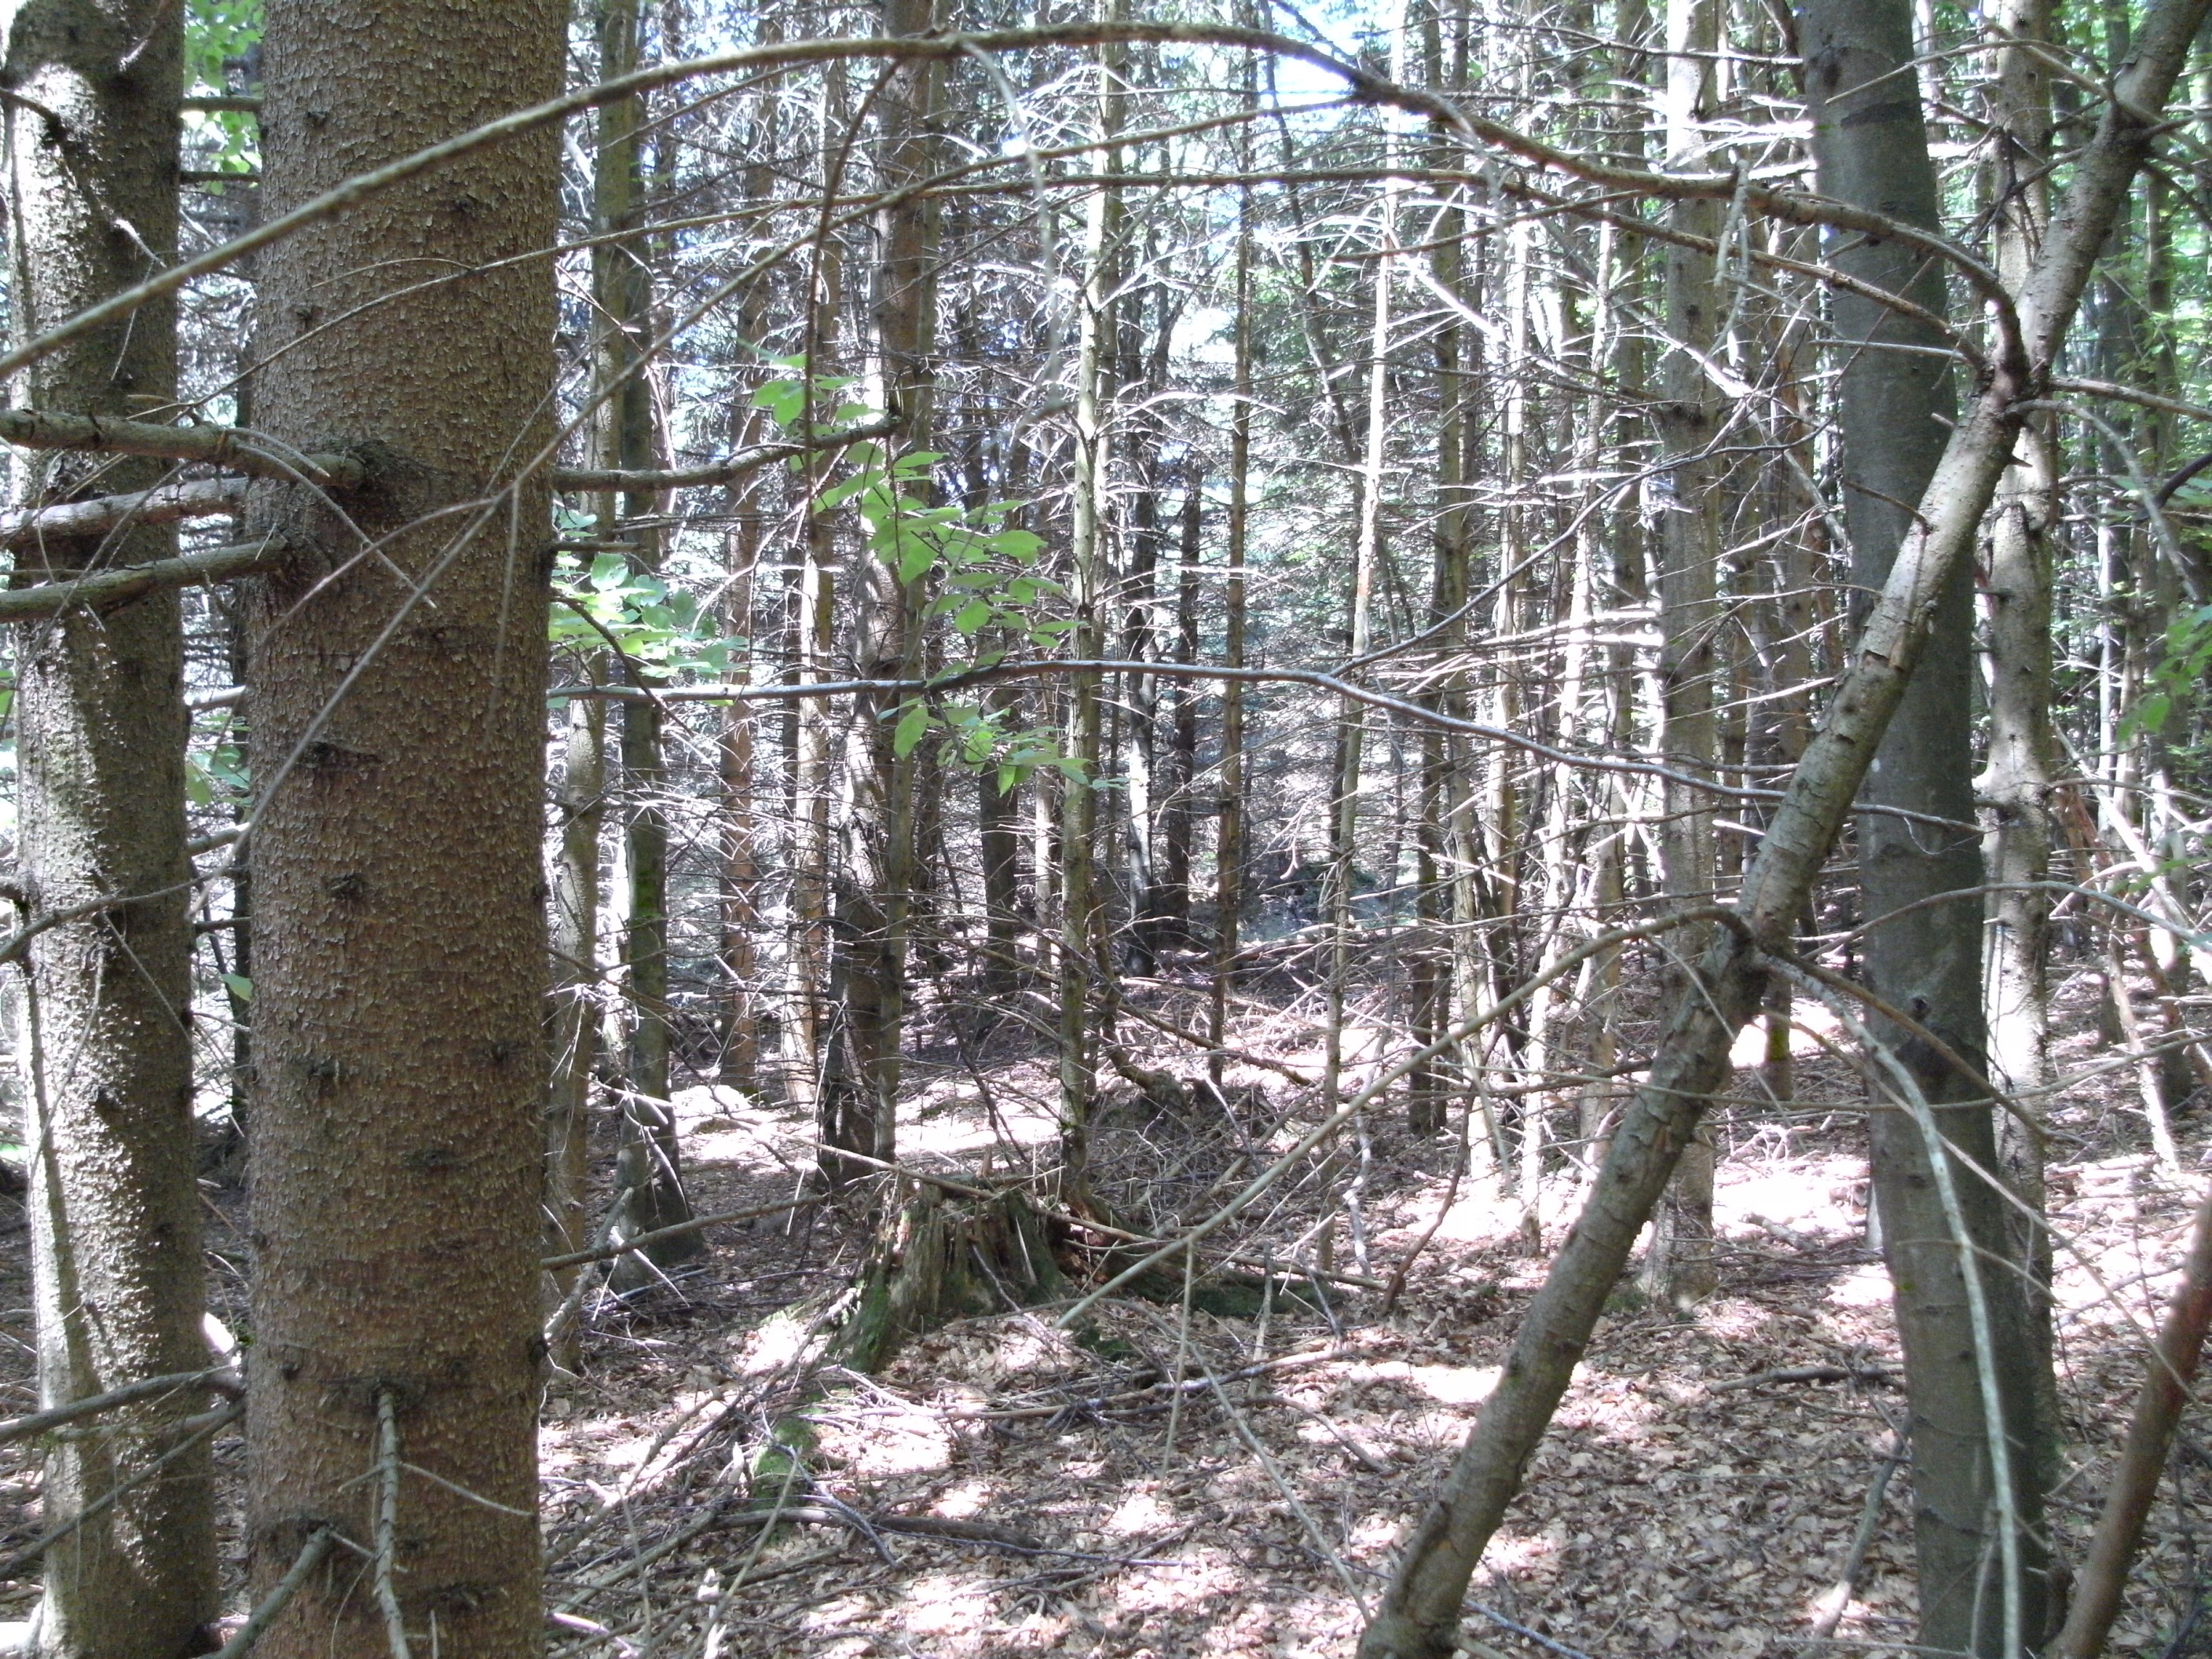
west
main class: Woodland
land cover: Broadleaved woodland
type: beech forest
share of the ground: > 75 %
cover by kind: broadleaved forest trees 85 %, coniferous forest trees 10 %, unconsolidated bare surface 5 %
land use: Forestry
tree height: > 5 m
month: June
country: AT
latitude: 48.0461
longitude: 13.3660
